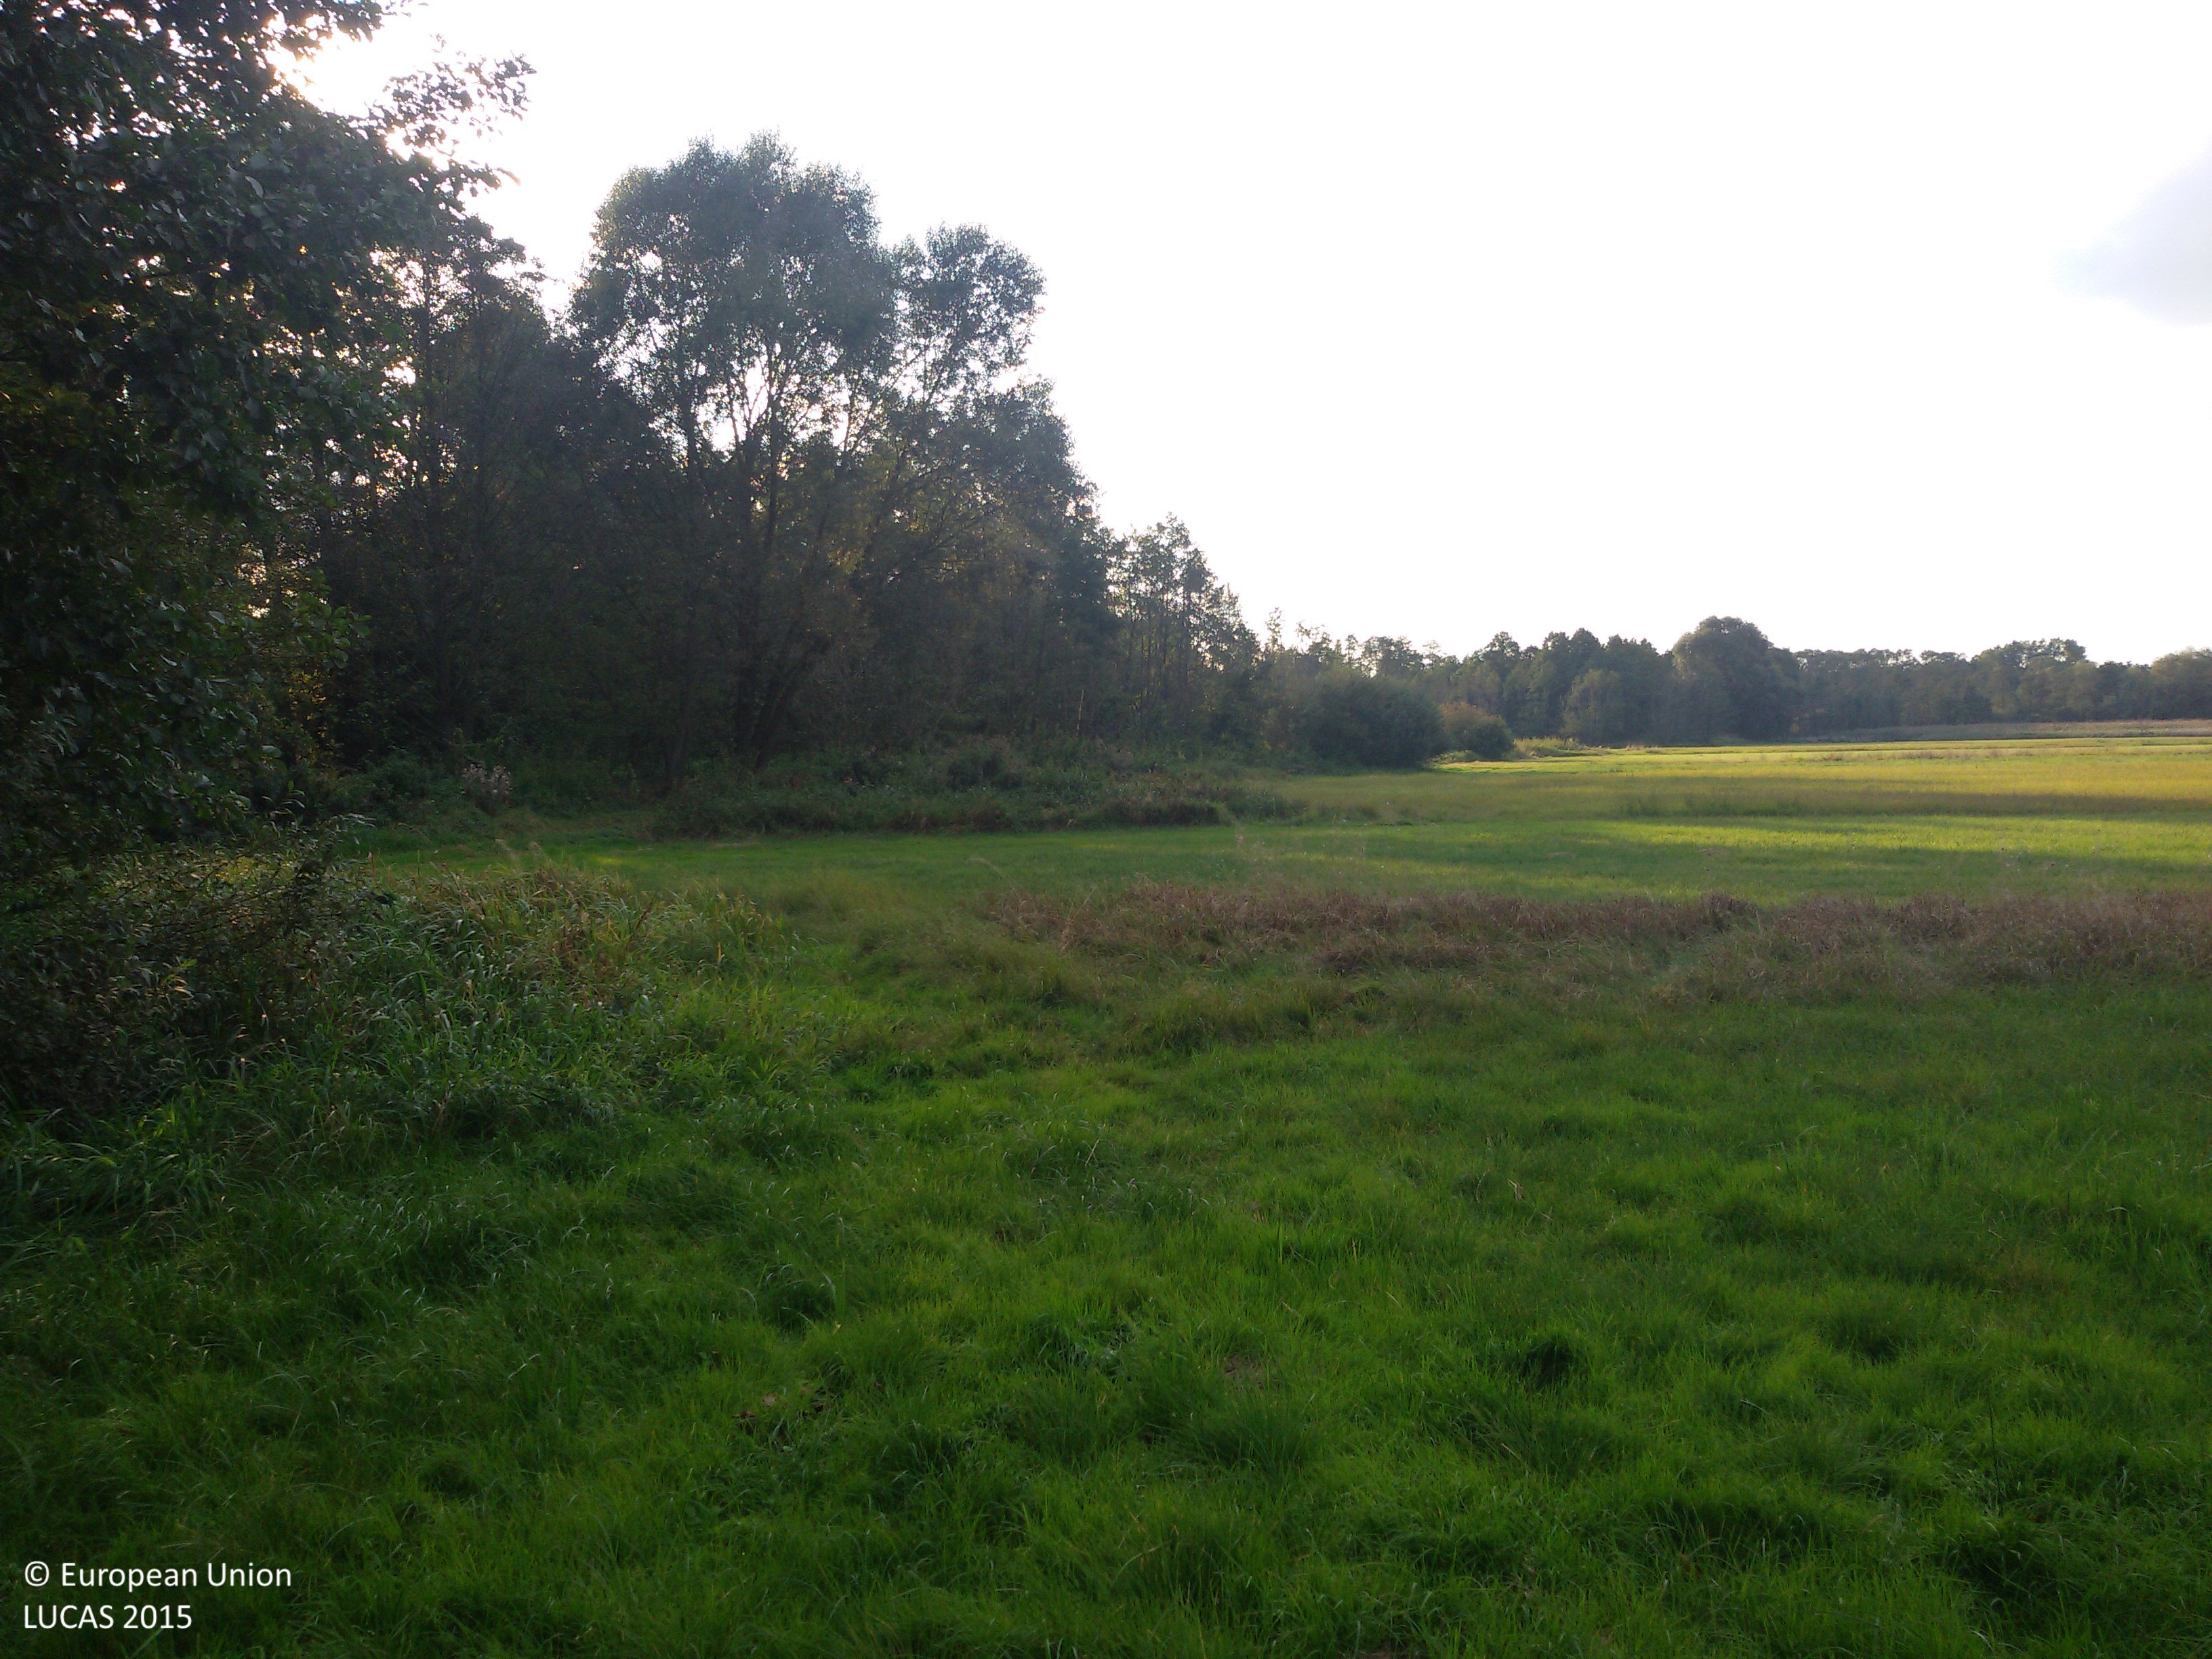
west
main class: Grassland
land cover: Grassland without tree/shrub cover
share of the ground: > 75 %
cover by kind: herbaceous plants 100 %
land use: Agriculture (excluding fallow land and kitchen gardens)
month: September
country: PL
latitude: 52.2003
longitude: 17.9602
